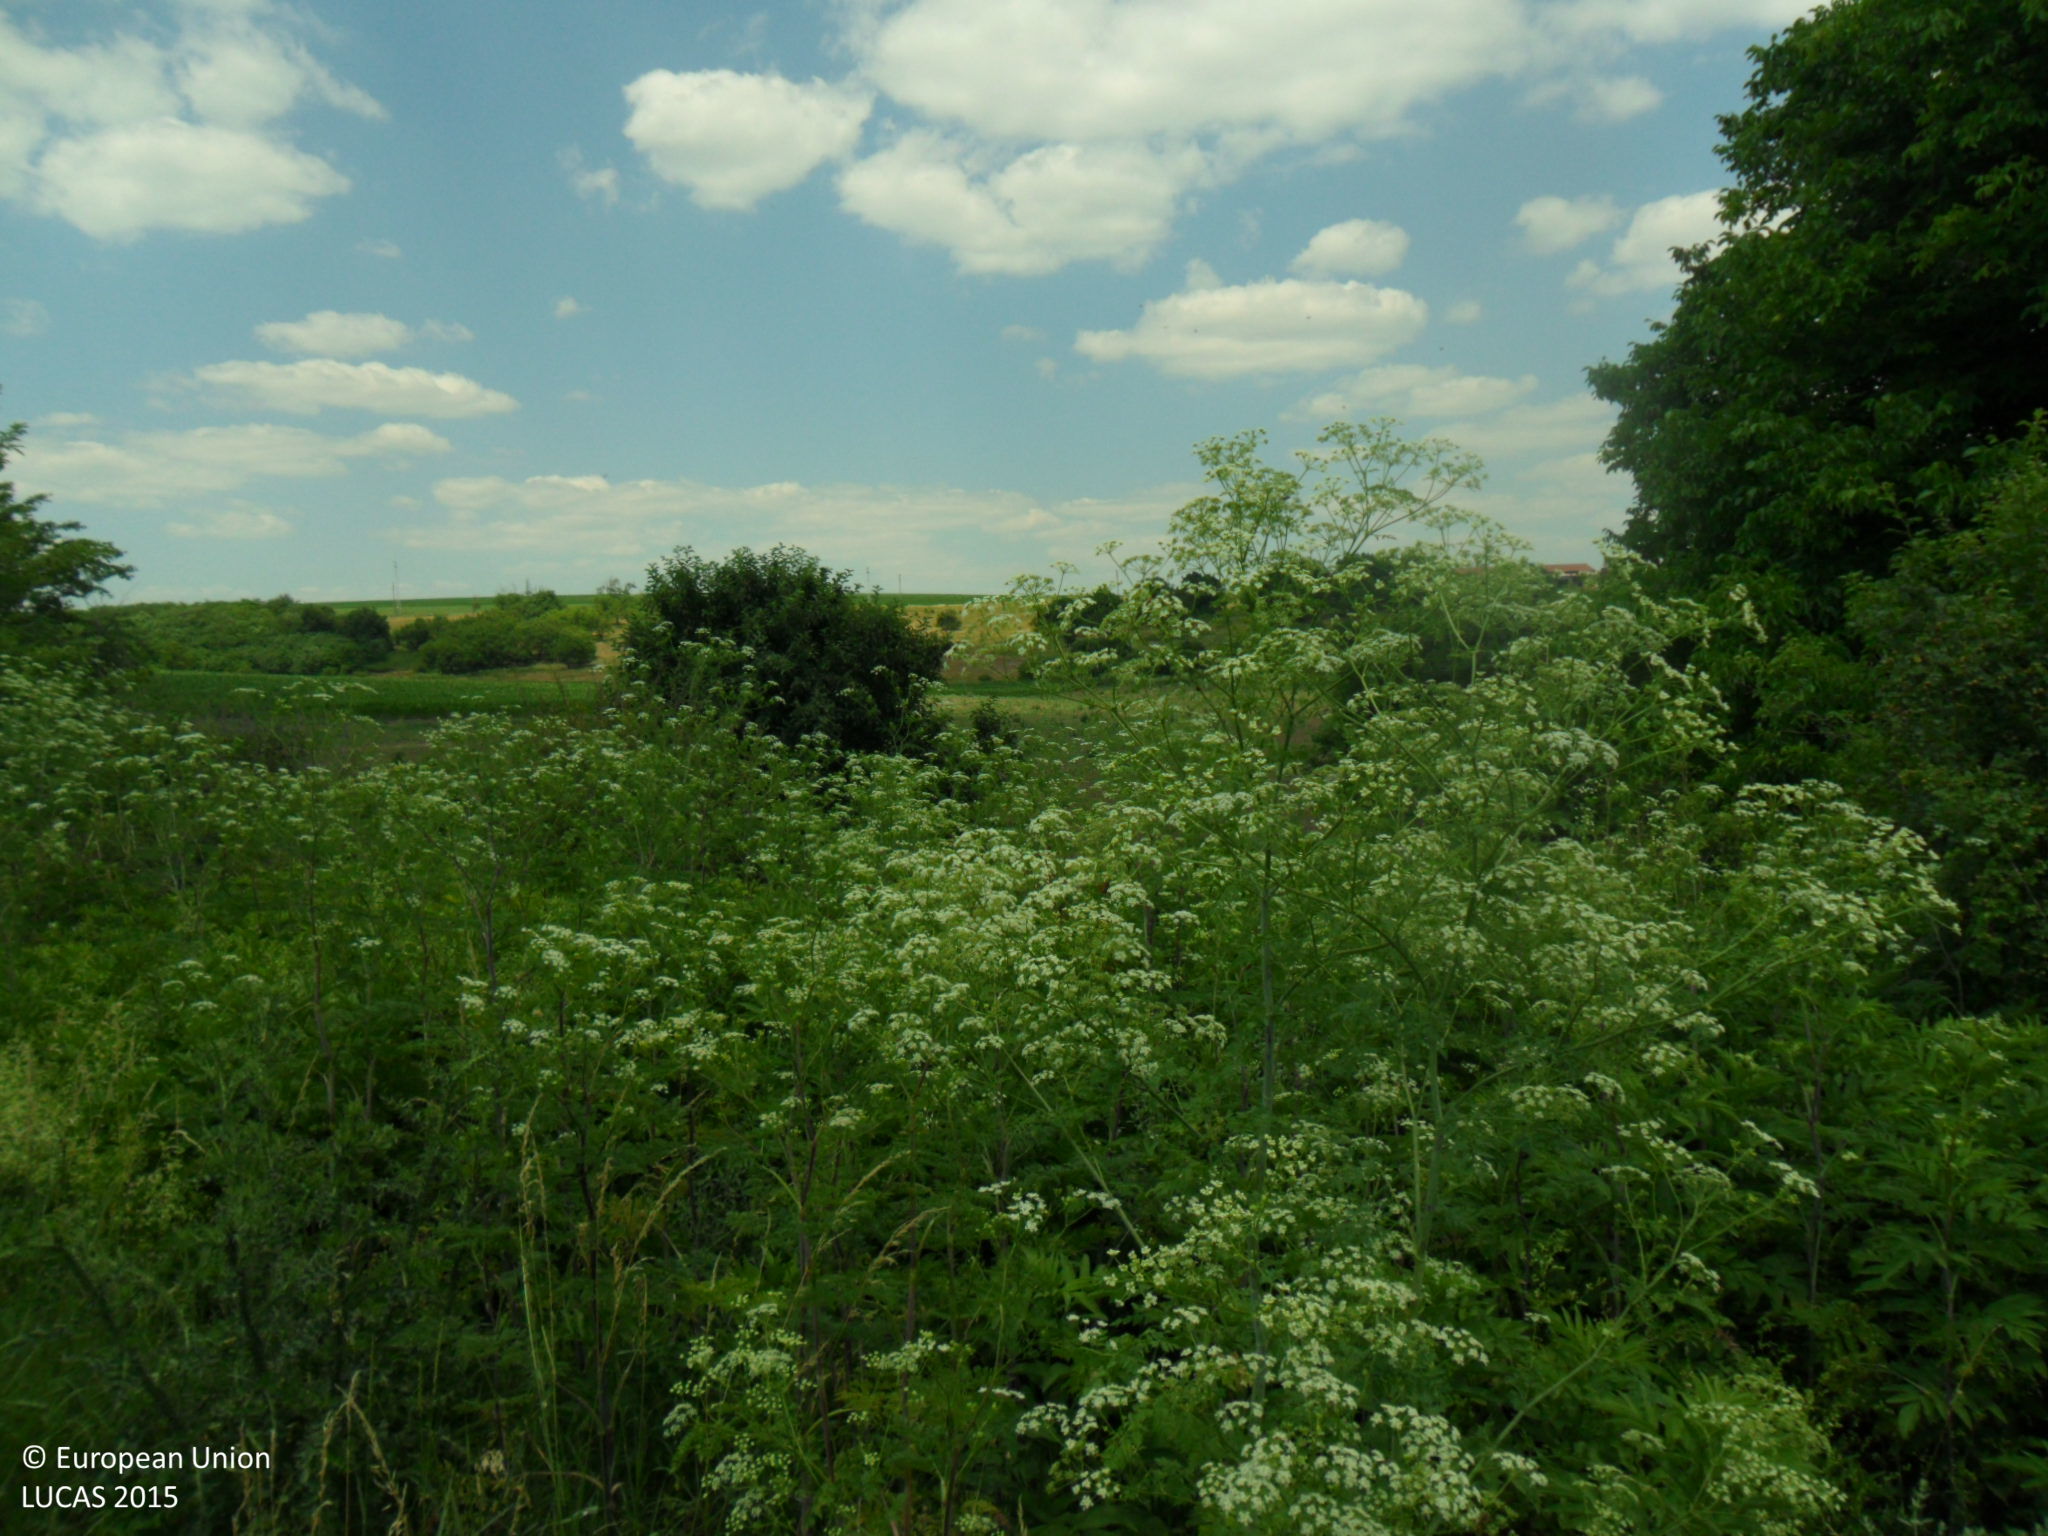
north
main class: Shrubland
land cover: Shrubland with sparse tree cover
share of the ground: > 75 %
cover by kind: shrubs 75 %, herbaceous plants 20 %, broadleaved forest trees 5 %
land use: Abandoned areas
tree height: > 5 m
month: June
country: BG
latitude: 43.4261
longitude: 26.9262
